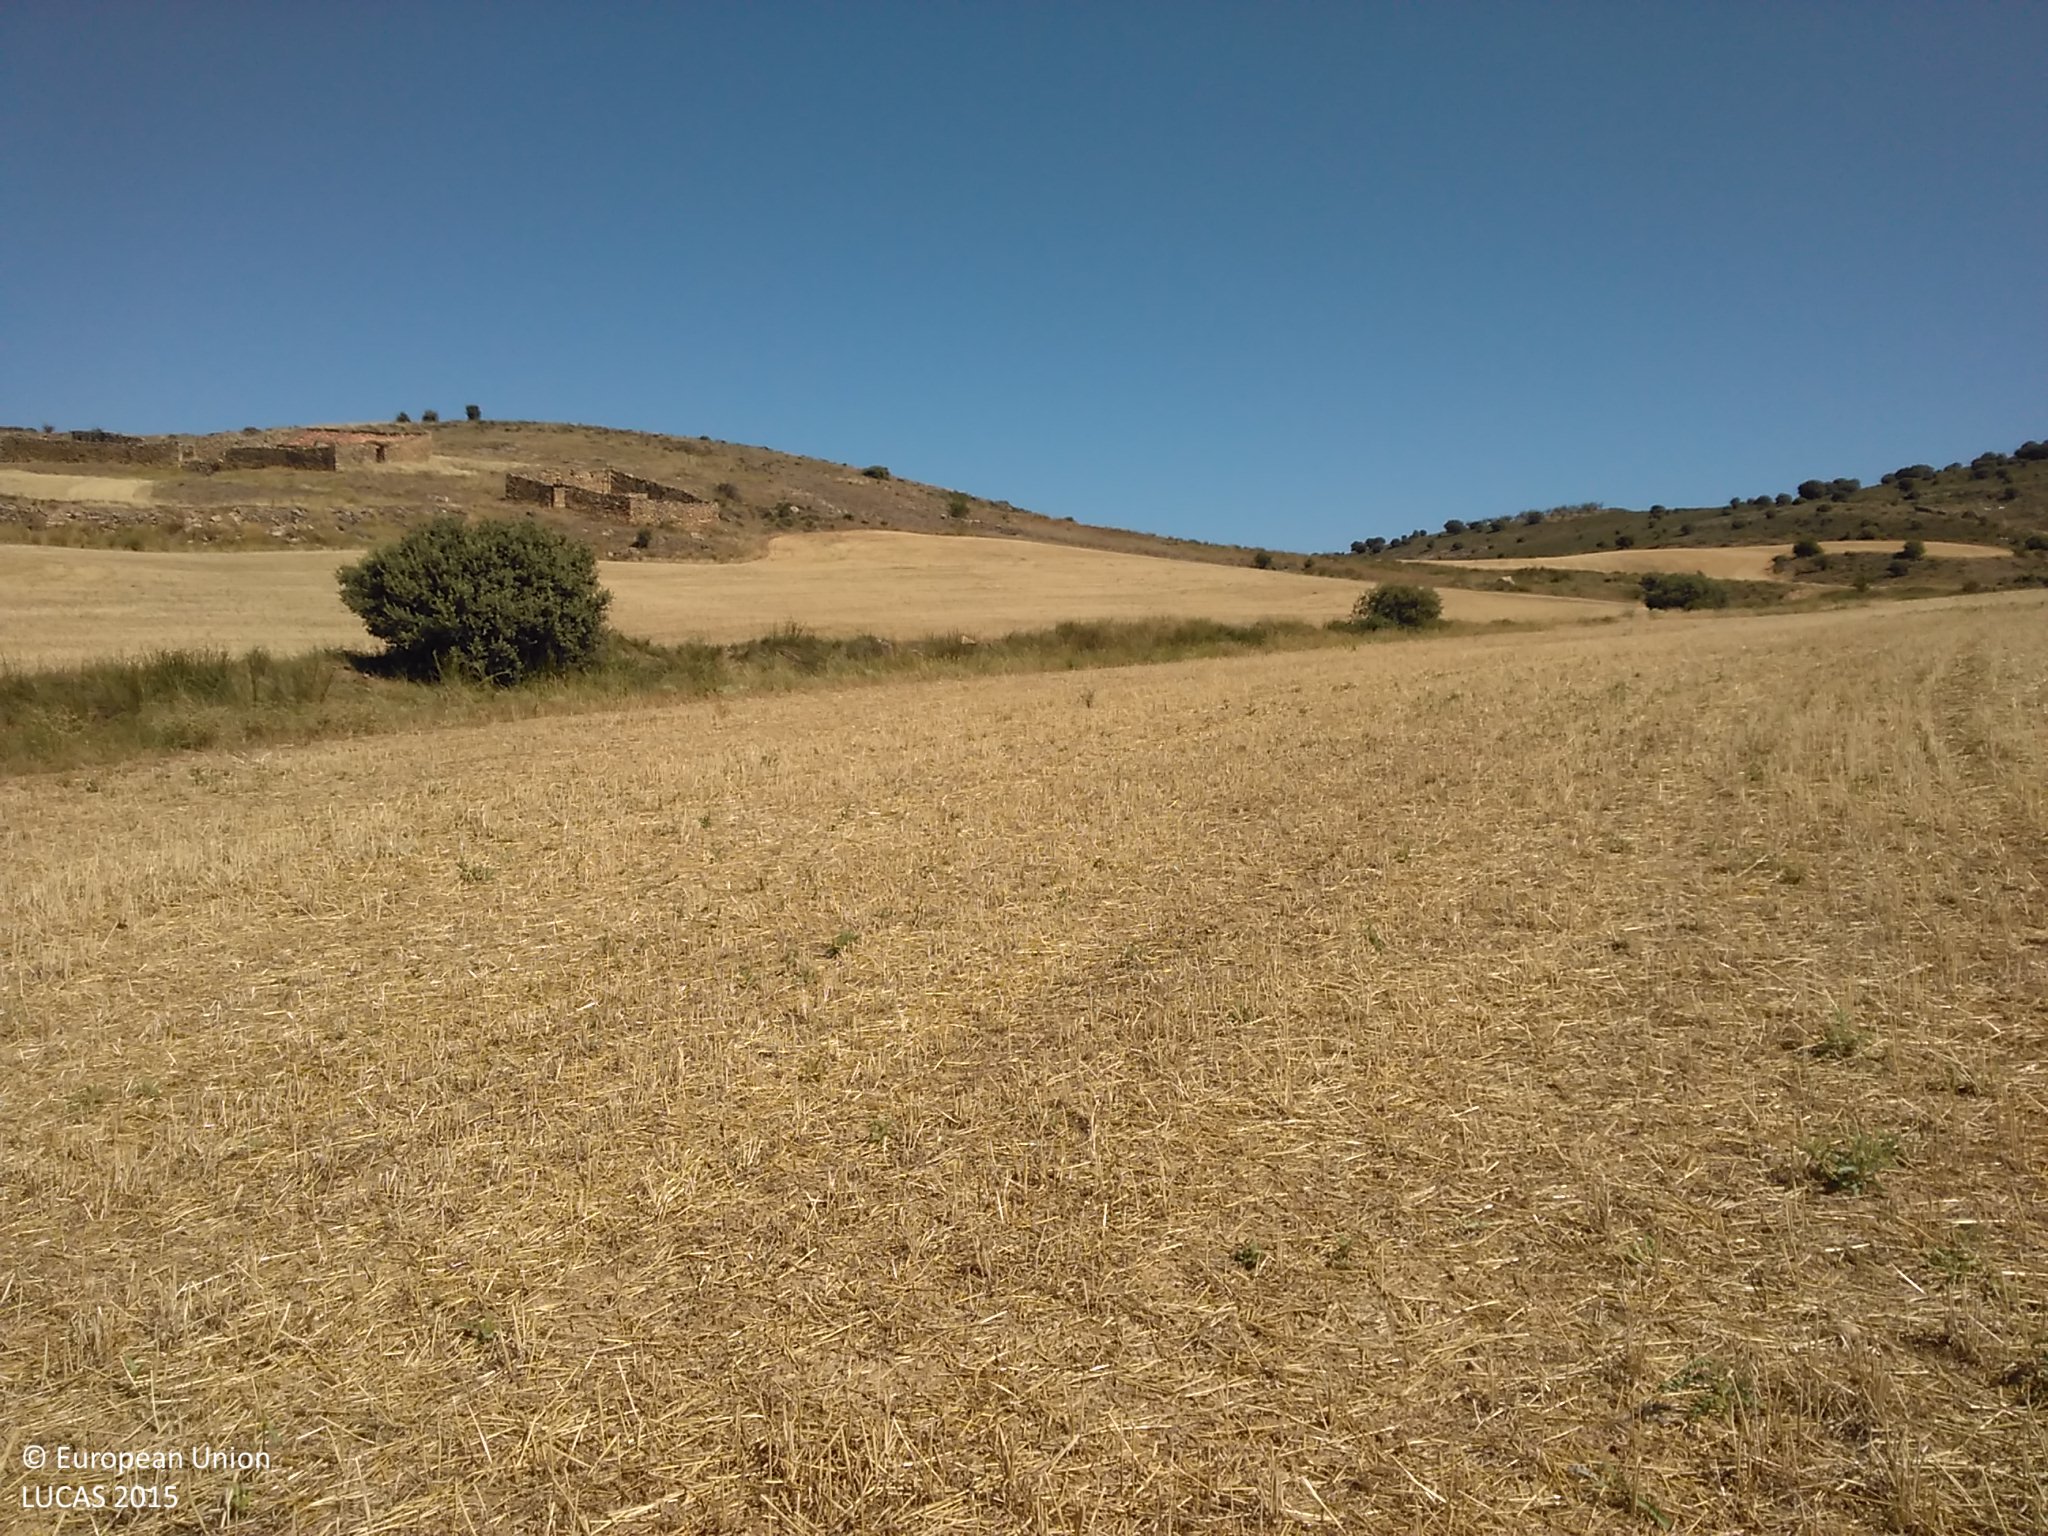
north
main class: Cropland
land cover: Common wheat
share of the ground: < 10 %
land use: Agriculture (excluding fallow land and kitchen gardens)
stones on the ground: < 10 %
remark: Harvested field
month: July
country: ES
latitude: 41.5566
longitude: -1.9846
